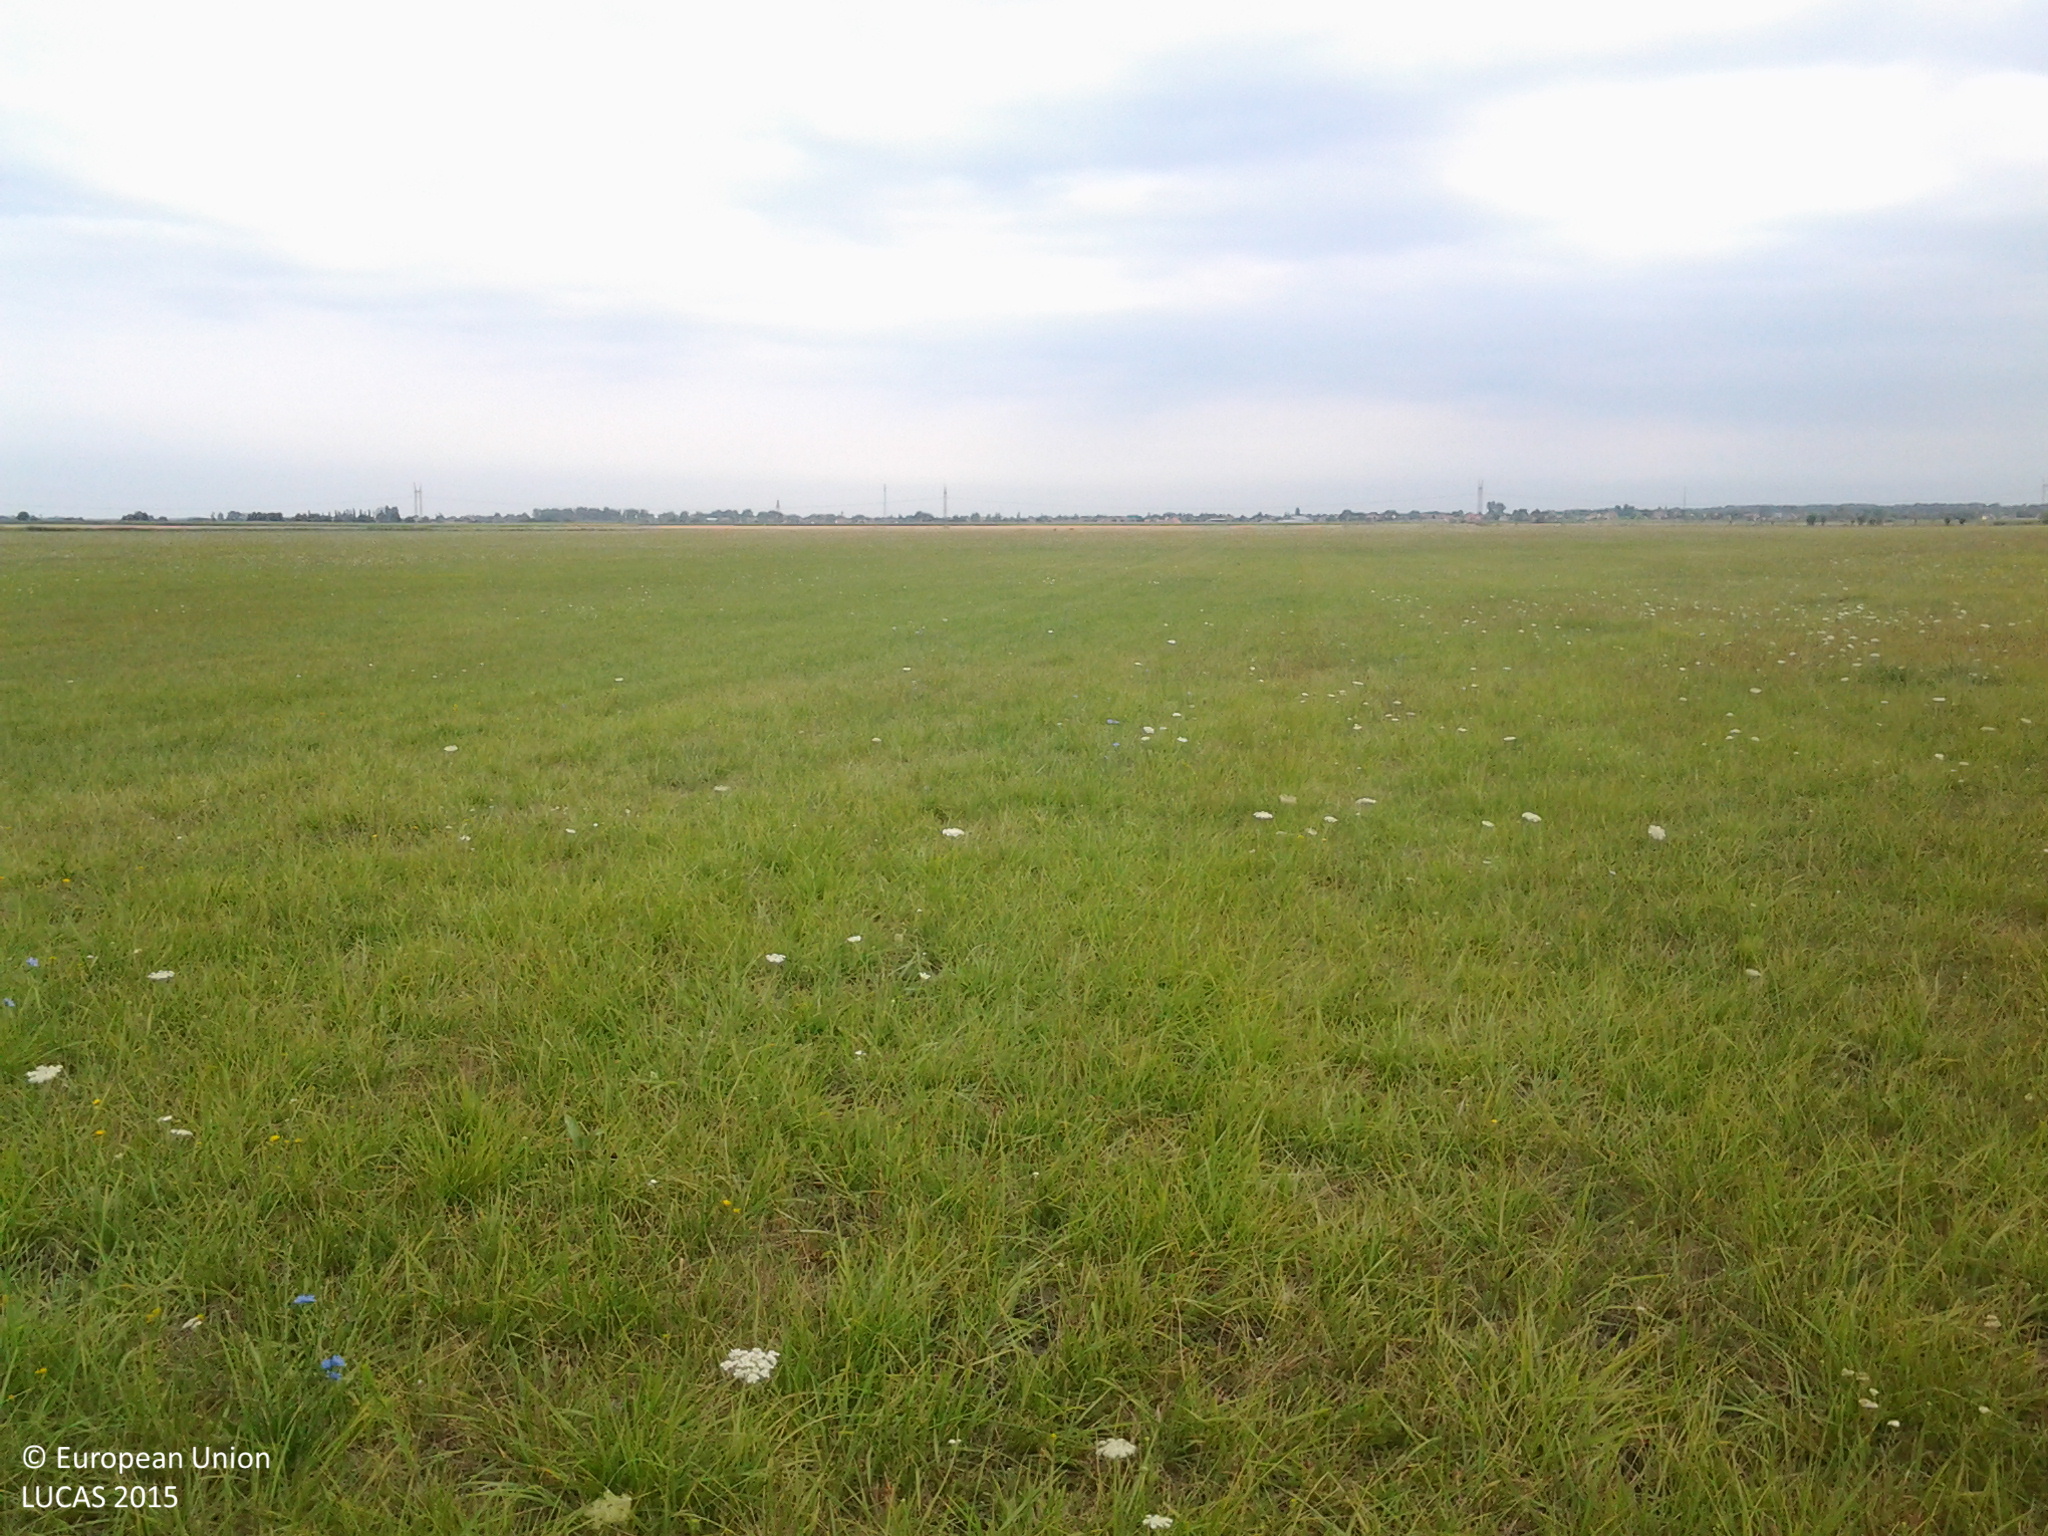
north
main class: Grassland
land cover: Grassland without tree/shrub cover
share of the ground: > 75 %
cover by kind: herbaceous plants 100 %
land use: Agriculture (excluding fallow land and kitchen gardens)
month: July
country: HU
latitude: 46.9481
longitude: 19.0153
